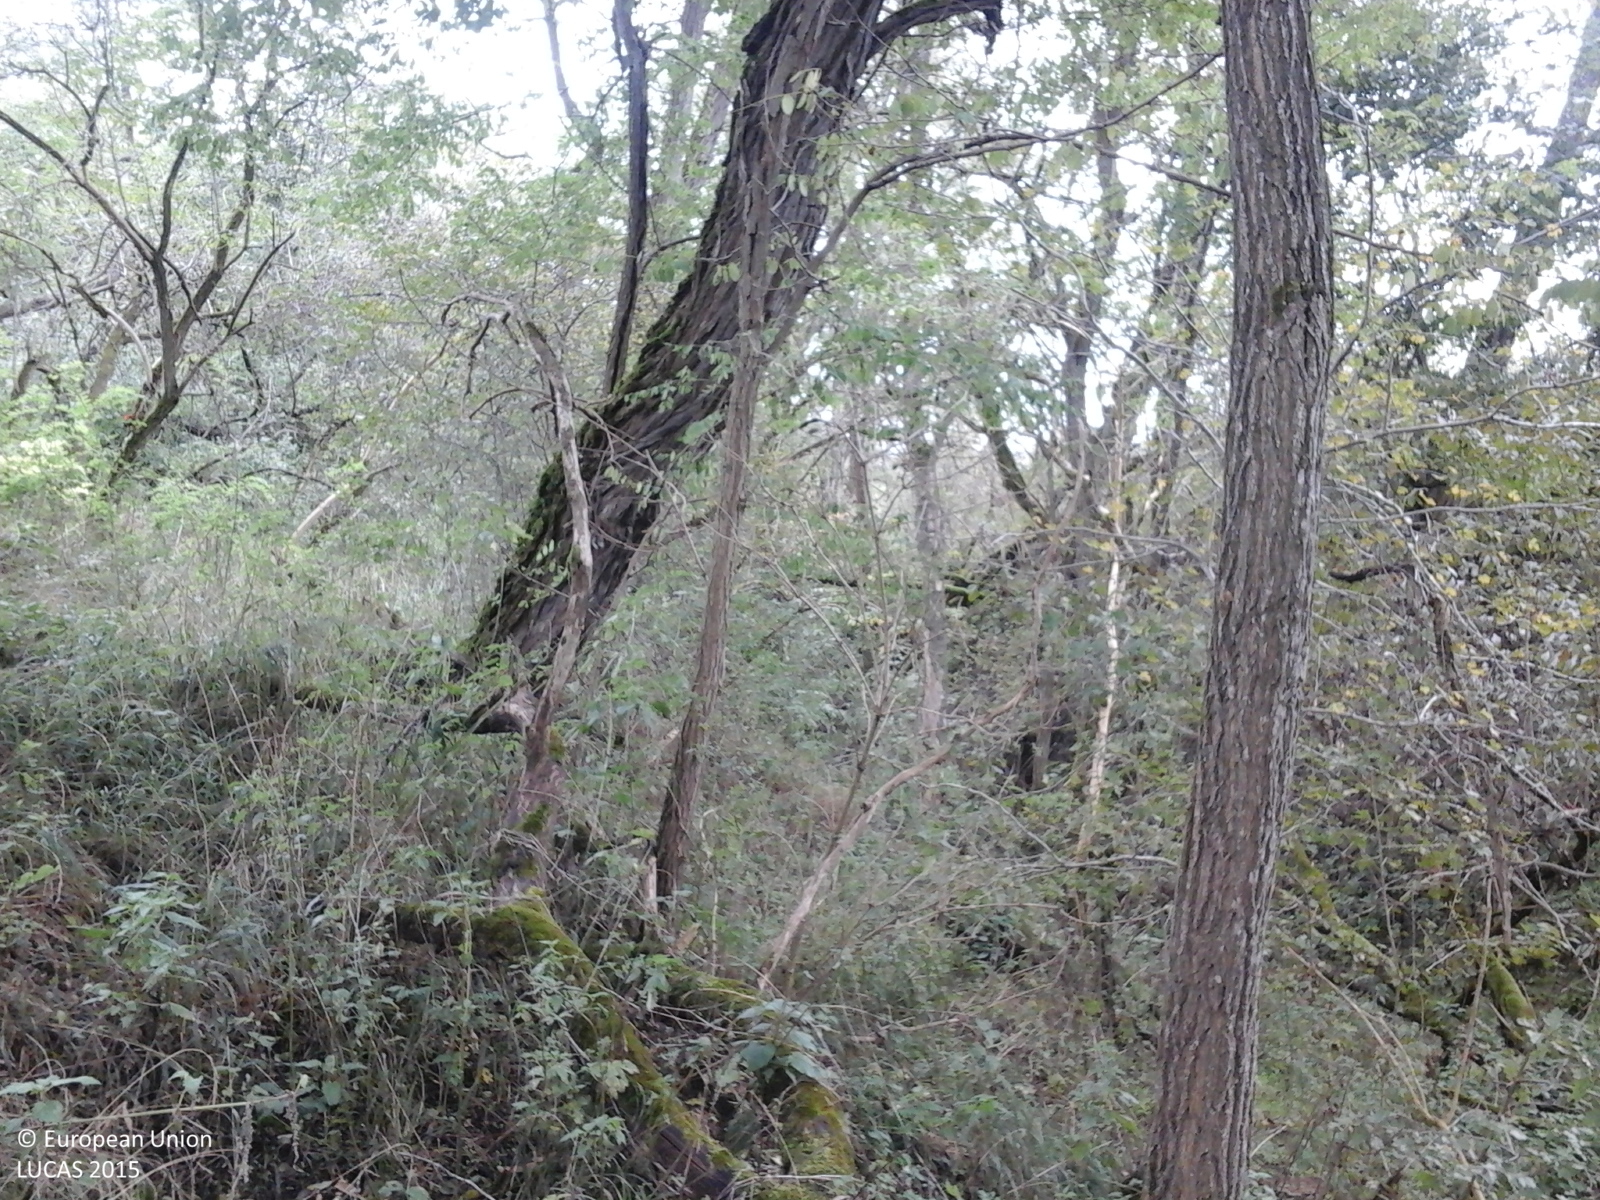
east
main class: Woodland
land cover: Broadleaved woodland
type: exotic forest
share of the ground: > 75 %
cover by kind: broadleaved forest trees 100 %
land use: Forestry
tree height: > 5 m
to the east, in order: Broadleaved woodland; Ditches and canals; Broadleaved woodland; Shrubland without tree cover; Grassland without tree/shrub cover; Broadleaved woodland; Ditches and canals; Broadleaved woodland; Spontaneously vegetated surfaces; Broadleaved woodland; Spontaneously vegetated surfaces
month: October
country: RO
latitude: 45.9045
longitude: 24.6385
